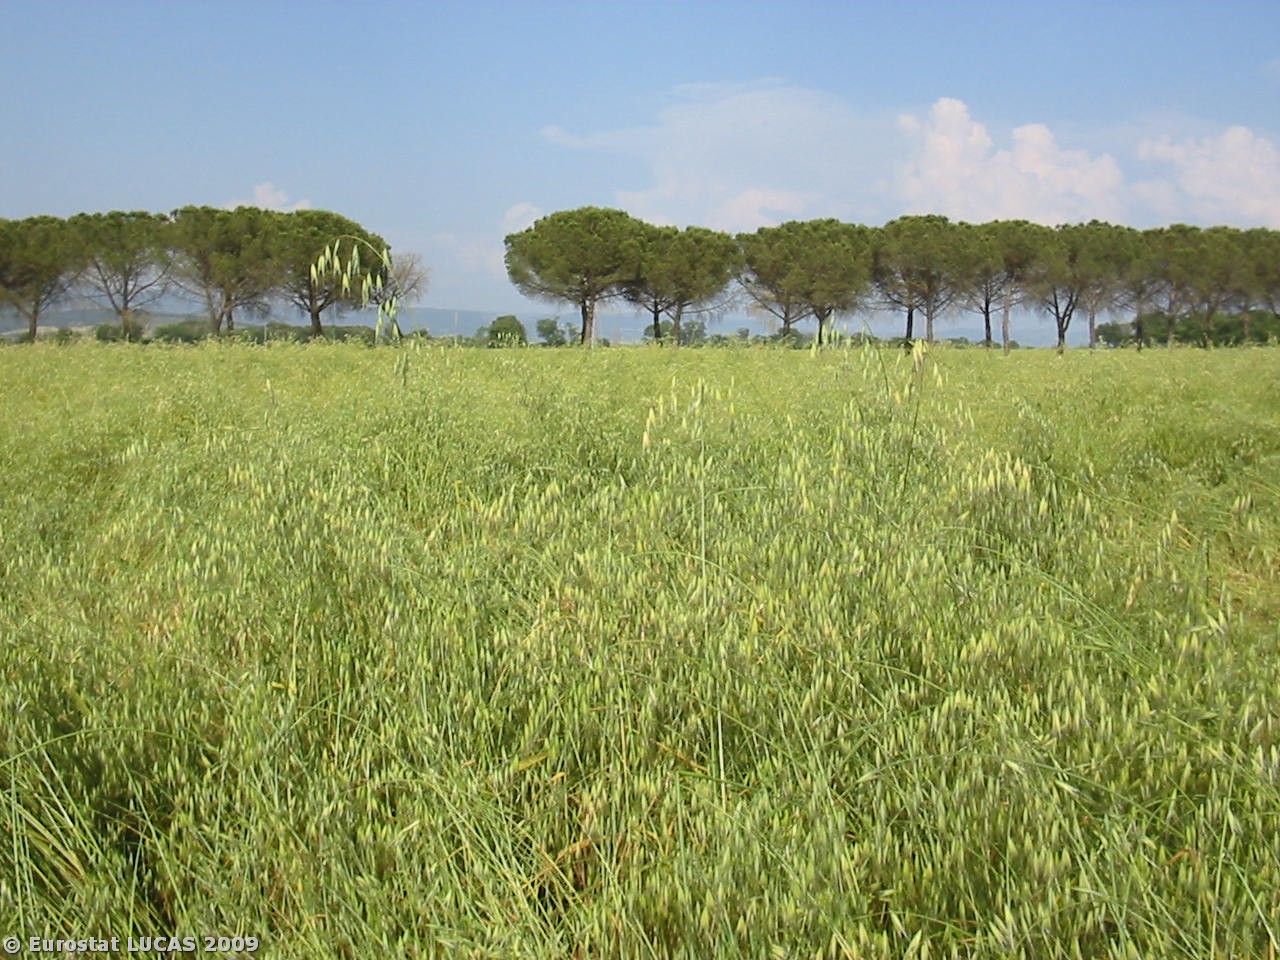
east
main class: Grassland
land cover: Spontaneously vegetated surfaces
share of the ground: > 75 %
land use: Fallow land
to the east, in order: Spontaneously vegetated surfaces; Lines of trees; Paved roads, cycling and walking lanes; Lines of trees; Spontaneously vegetated surfaces
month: May
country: IT
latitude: 43.1761
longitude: 11.9994
